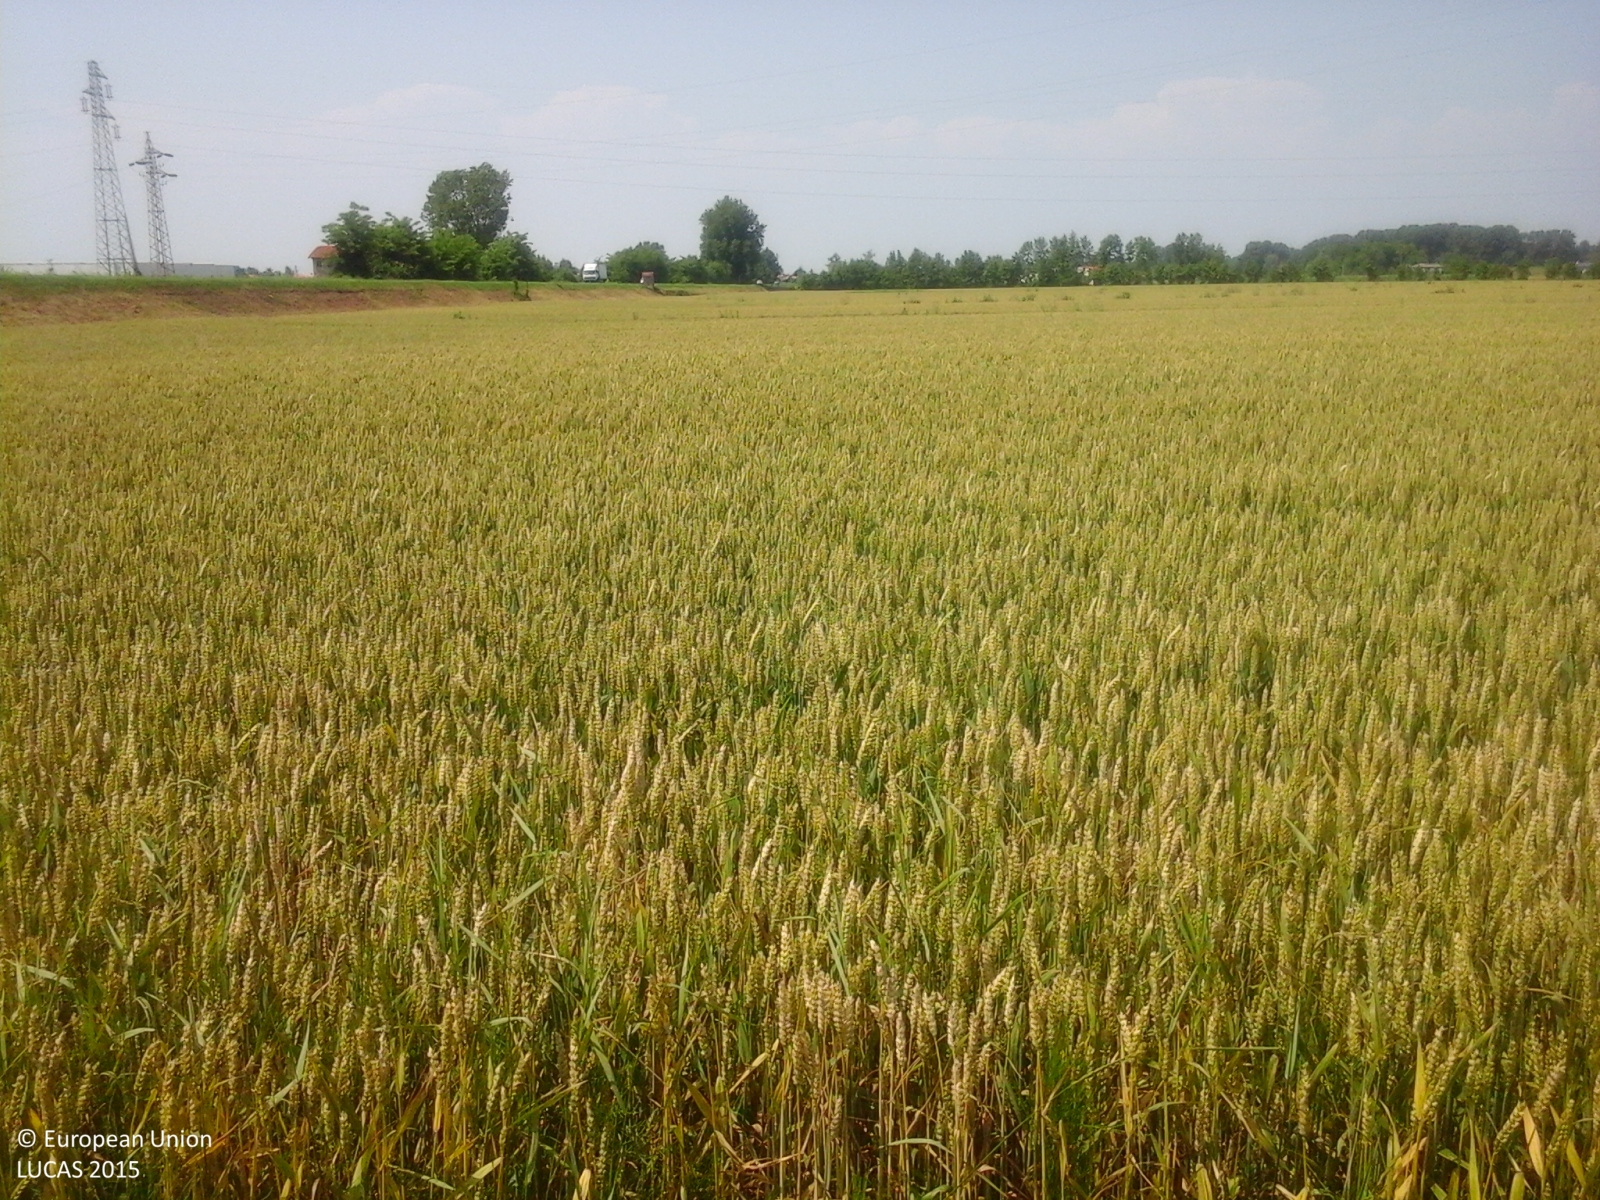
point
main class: Cropland
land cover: Common wheat
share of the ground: > 75 %
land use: Agriculture (excluding fallow land and kitchen gardens)
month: June
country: IT
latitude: 45.6365
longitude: 12.5236
